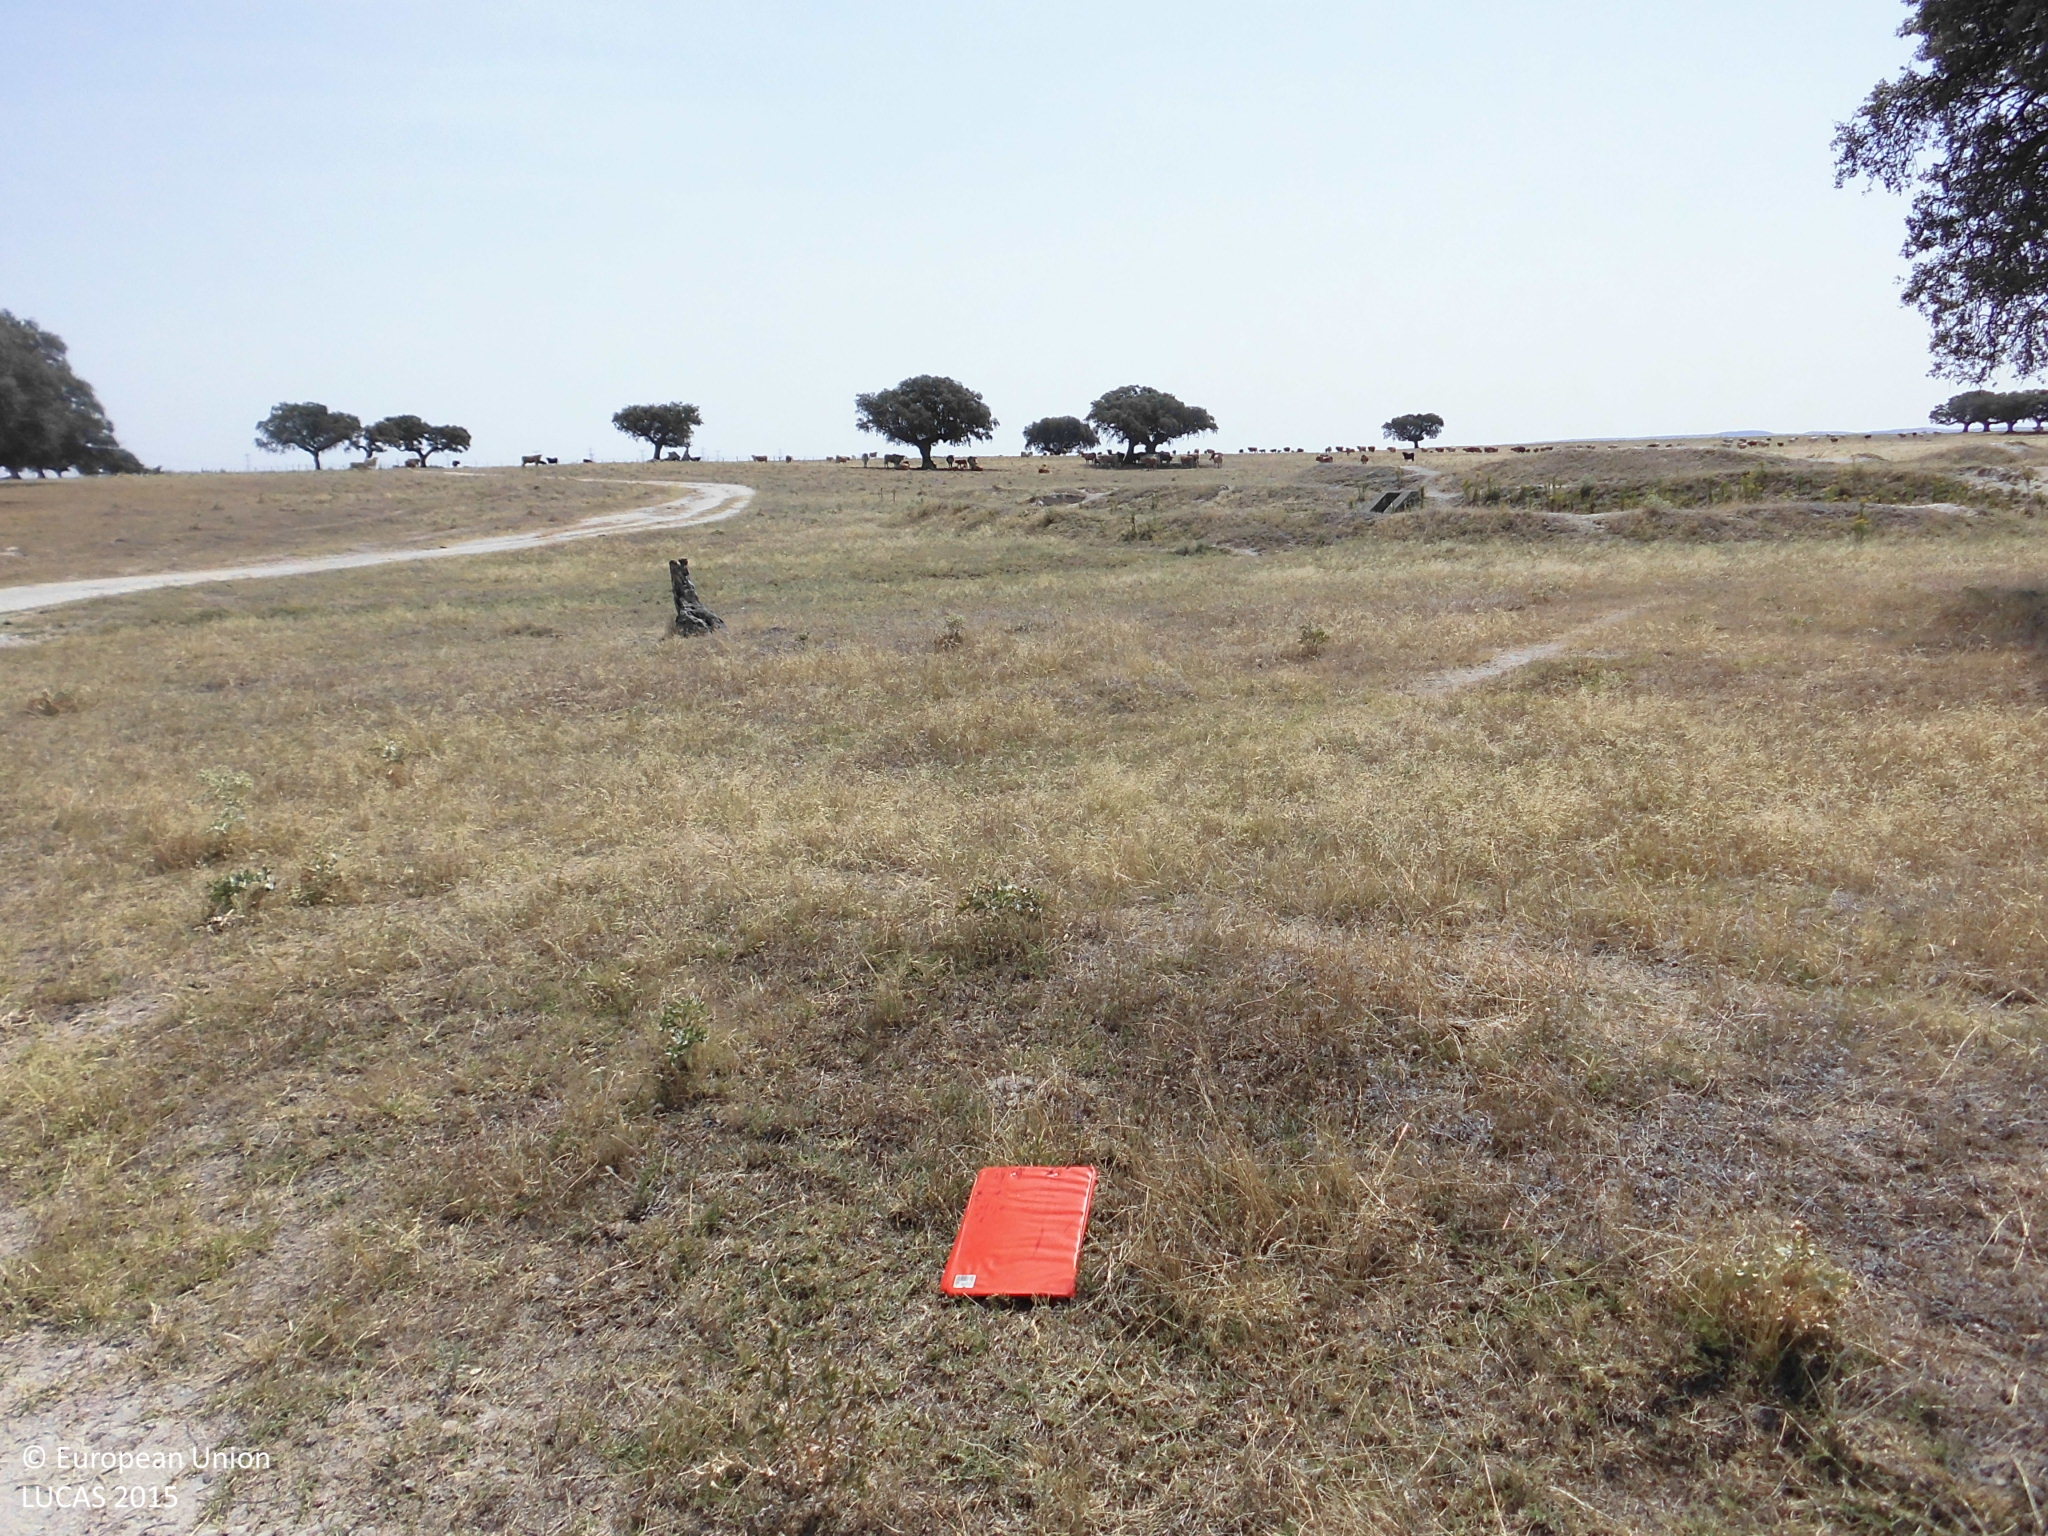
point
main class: Woodland
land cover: Broadleaved woodland
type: broadleaved evergreen forest
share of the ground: 10 - 25 %
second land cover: Grassland without tree/shrub cover
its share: > 75 %
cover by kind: herbaceous plants 85 %, broadleaved forest trees 10 %, unconsolidated bare surface 5 %
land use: Forestry
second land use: Agriculture (excluding fallow land and kitchen gardens)
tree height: > 5 m
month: July
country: ES
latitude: 39.9047
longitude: -5.4150
